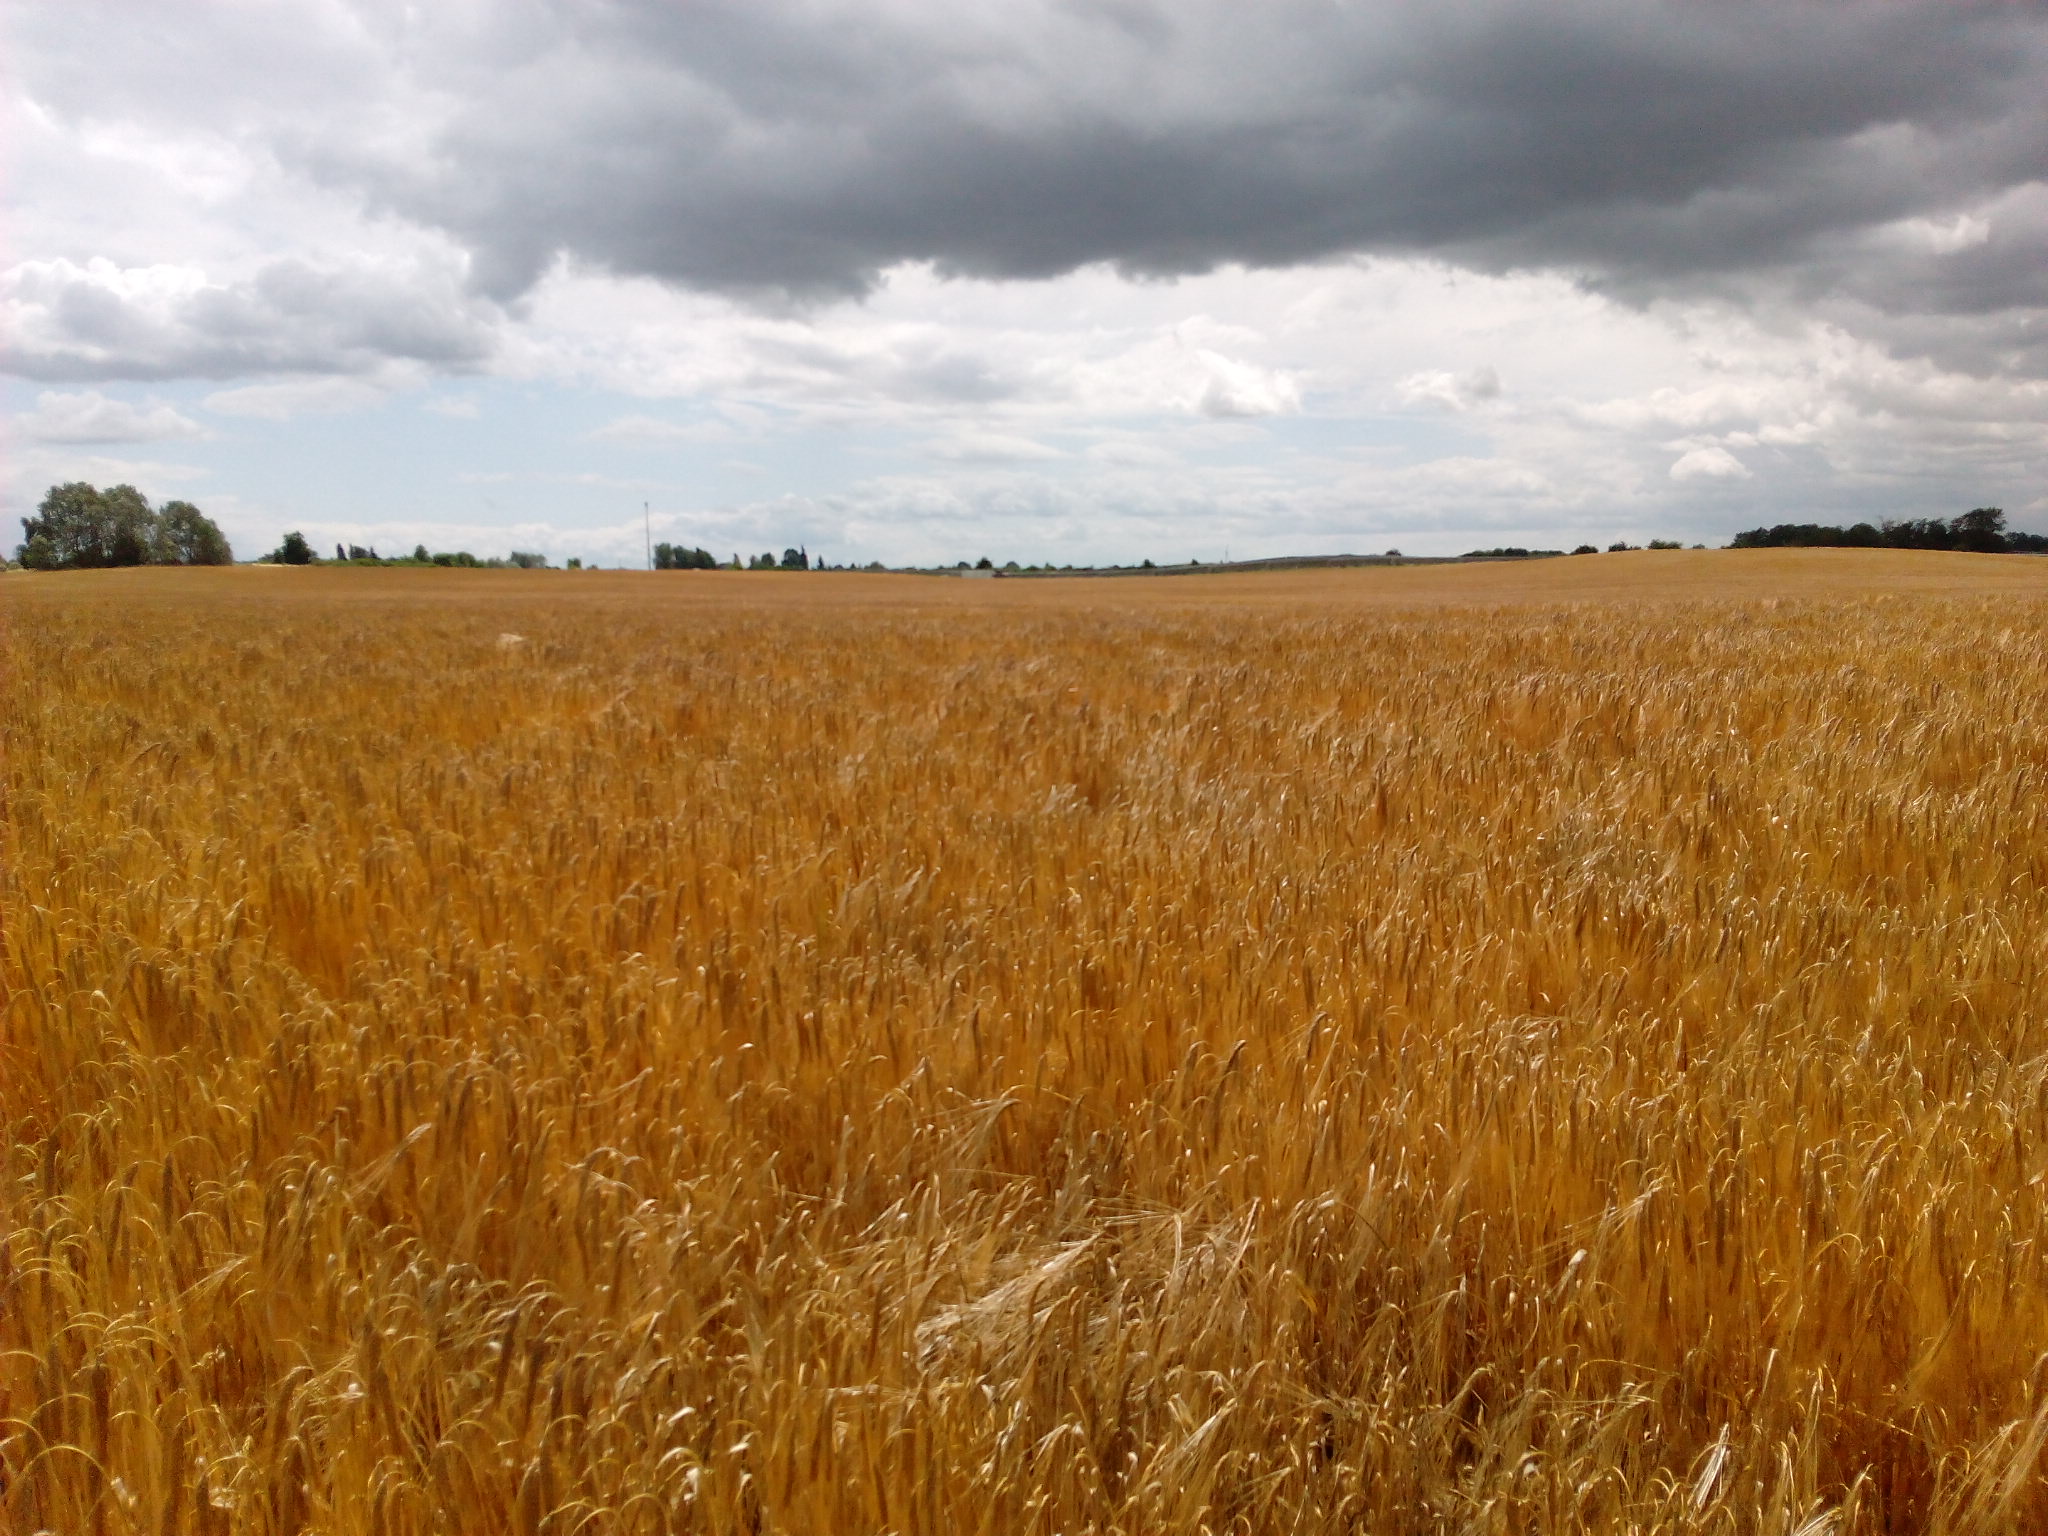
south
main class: Cropland
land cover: Barley
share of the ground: > 75 %
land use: Agriculture (excluding fallow land and kitchen gardens)
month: July
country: DE
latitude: 53.4340
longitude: 14.2906
